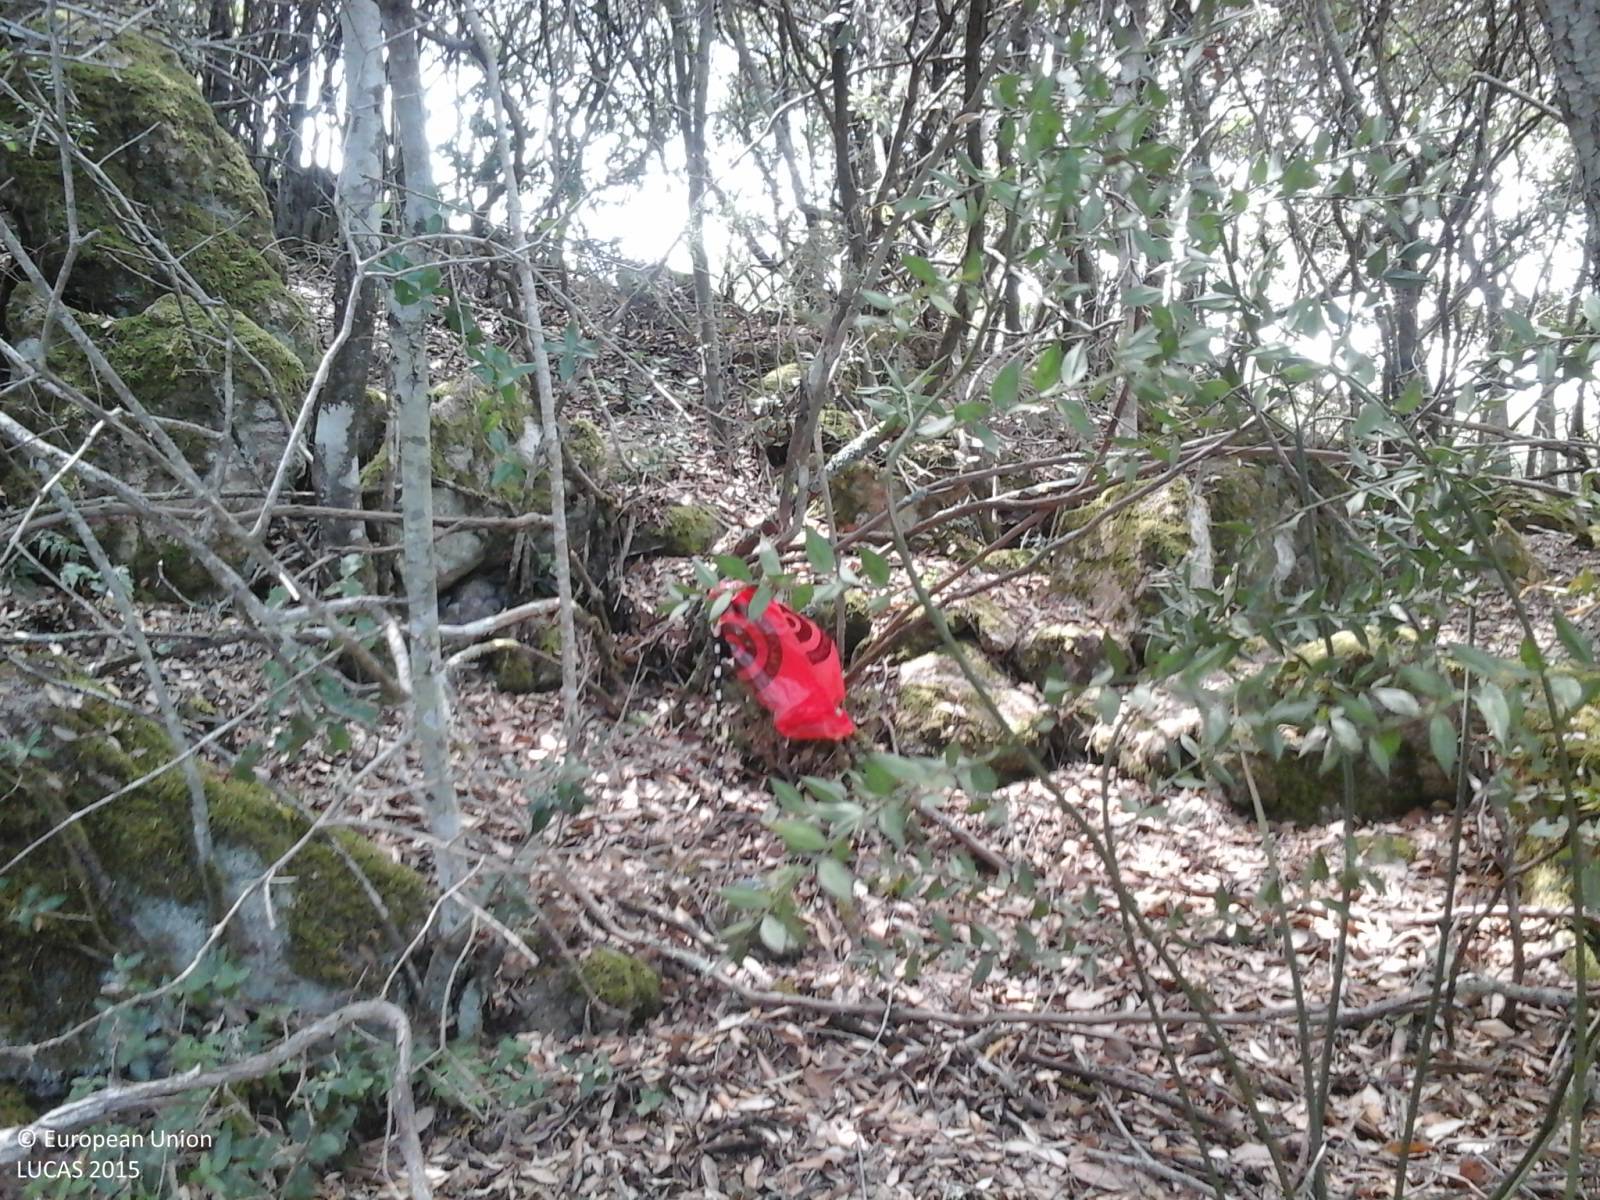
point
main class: Woodland
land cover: Broadleaved woodland
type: broadleaved evergreen forest
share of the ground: > 75 %
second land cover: Grassland without tree/shrub cover
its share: > 75 %
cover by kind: broadleaved forest trees 75 %, herbaceous plants 25 %
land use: Forestry
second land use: Agriculture (excluding fallow land and kitchen gardens)
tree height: > 5 m
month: June
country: IT
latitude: 40.6820
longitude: 9.4466
